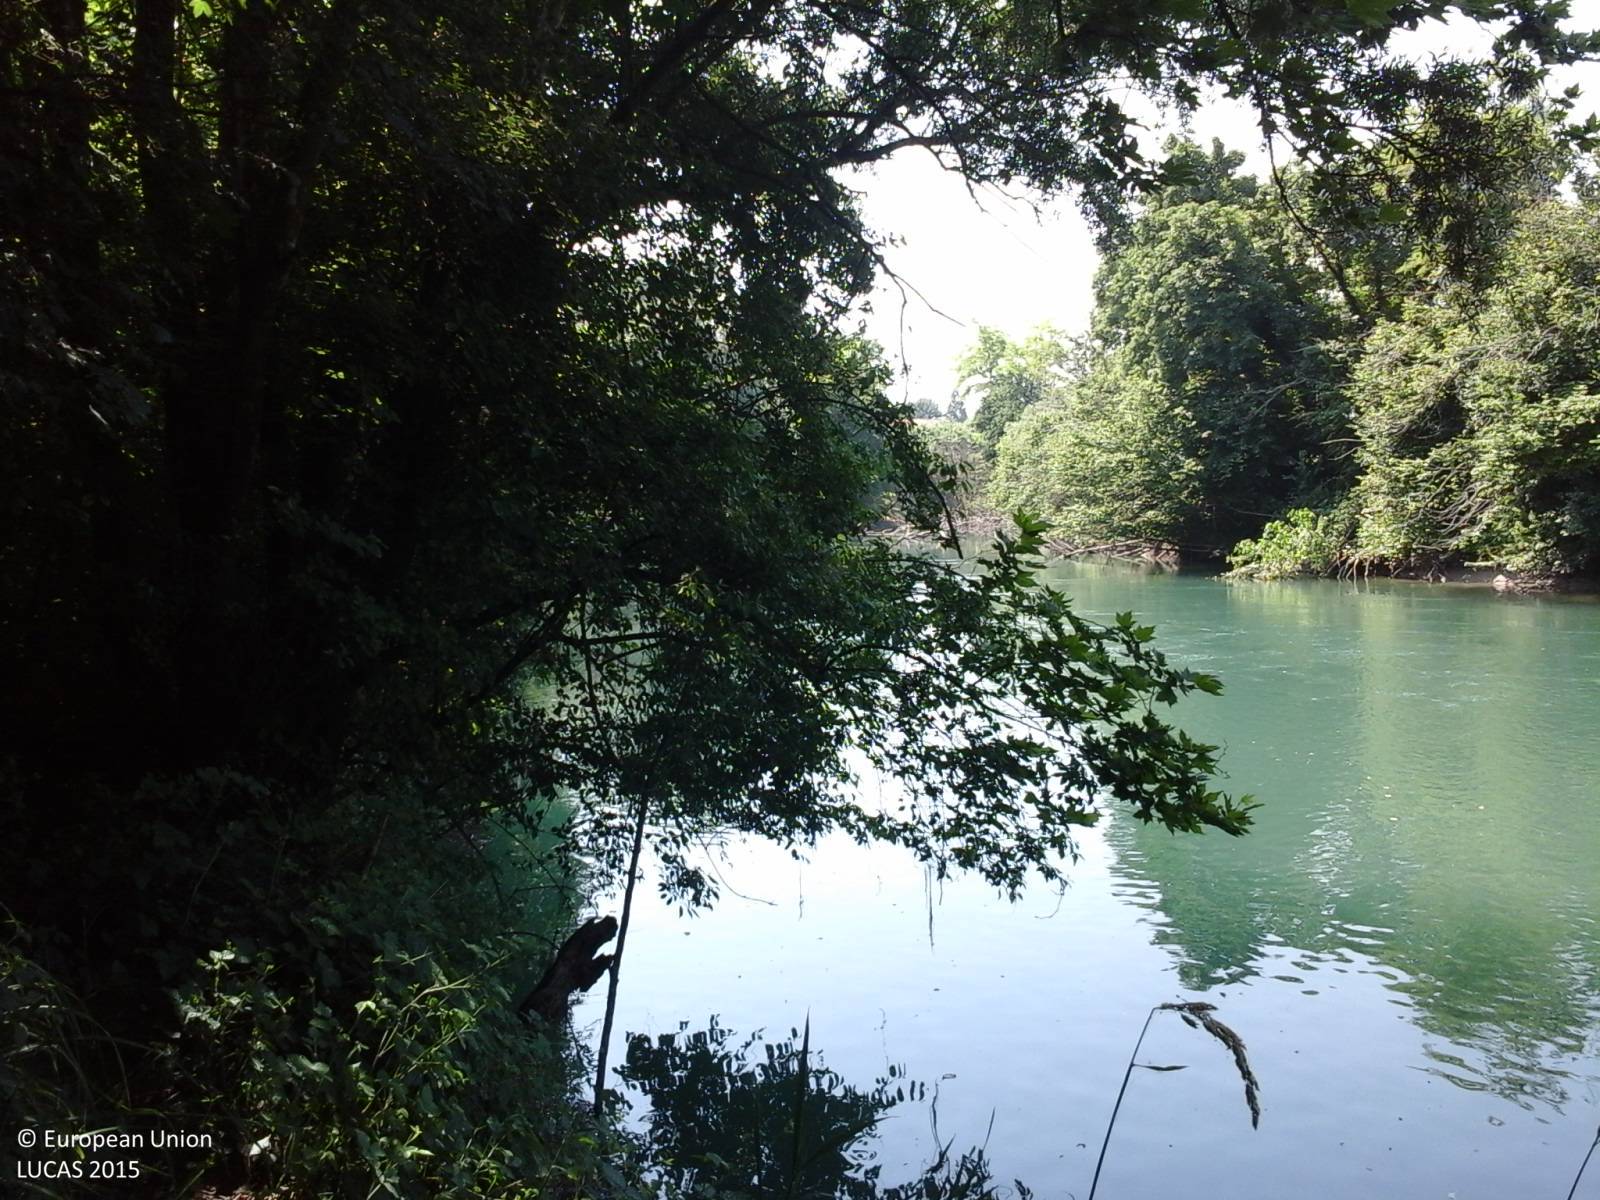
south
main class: Woodland
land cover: Broadleaved woodland
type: floodplain forest
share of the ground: > 75 %
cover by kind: broadleaved forest trees 70 %, shrubs 30 %
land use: Semi-natural and natural areas not in use
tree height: > 5 m
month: June
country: IT
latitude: 45.9252
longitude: 12.5112
